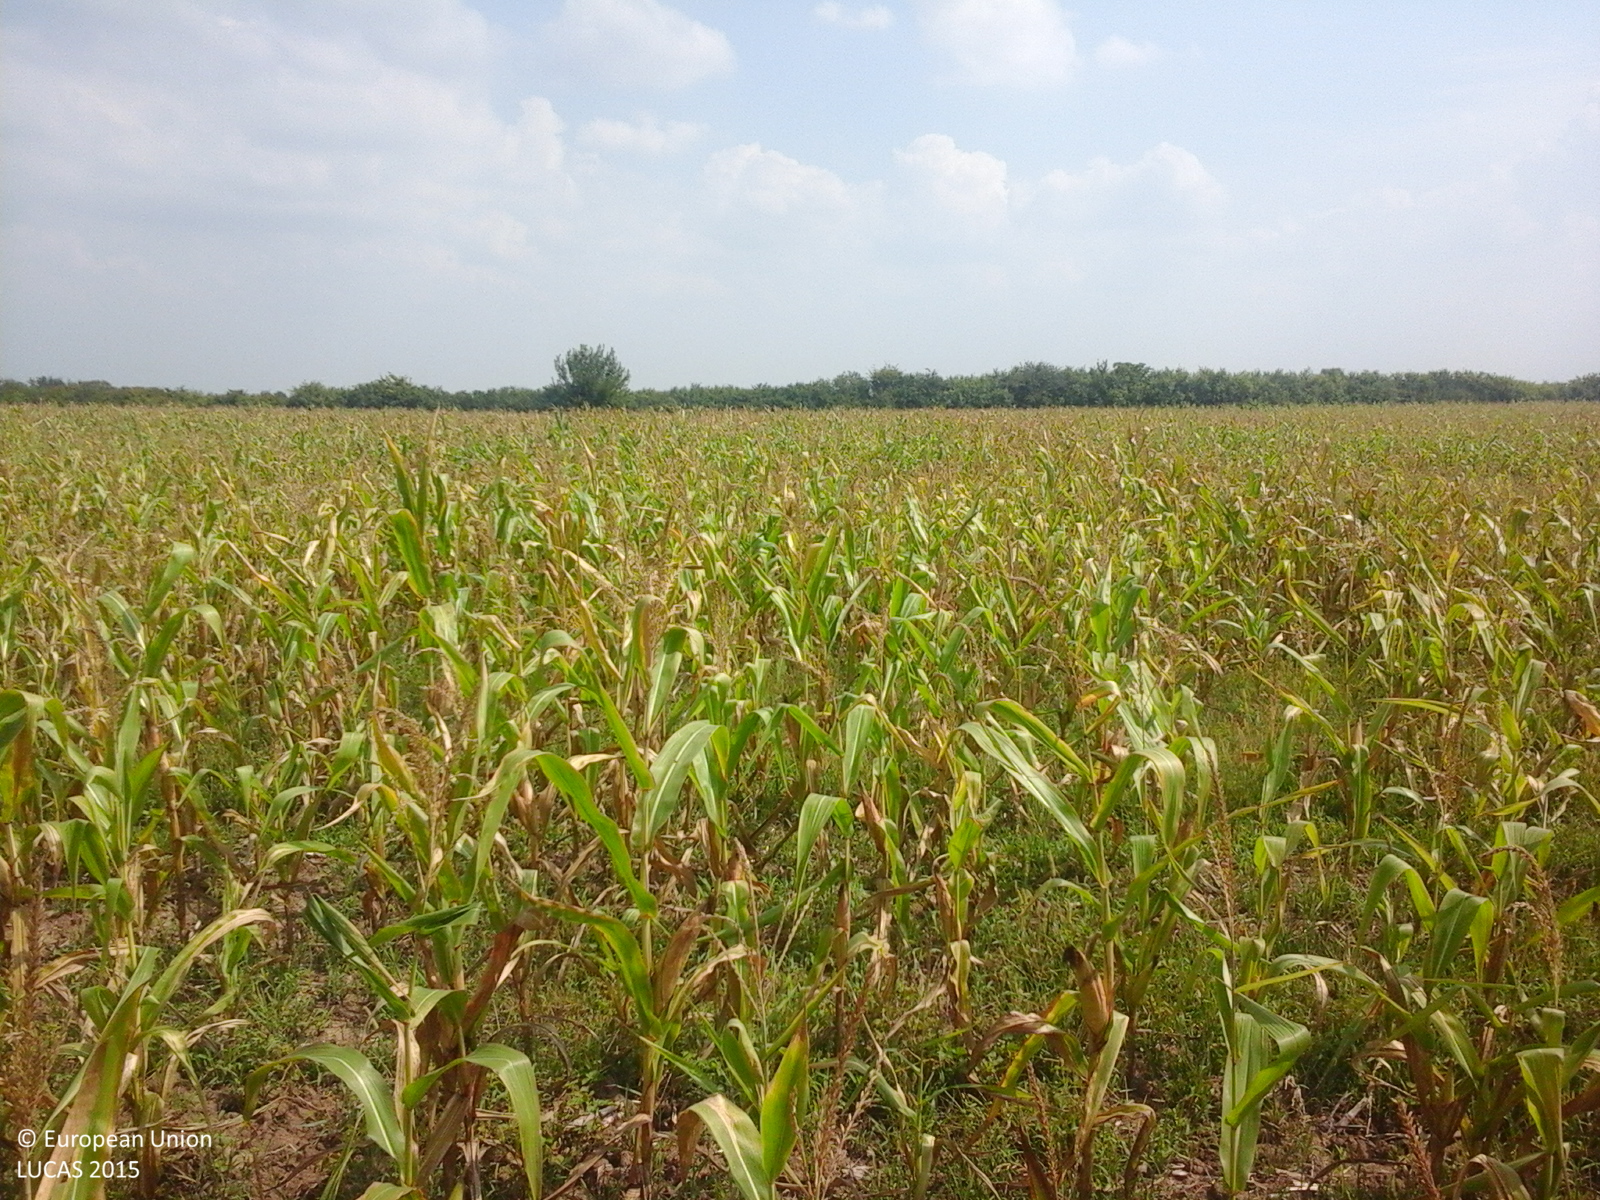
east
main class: Cropland
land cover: Maize
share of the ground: 50 - 75 %
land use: Agriculture (excluding fallow land and kitchen gardens)
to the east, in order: Maize; Spontaneously vegetated surfaces; Abandoned hedges; Ditches and canals; Abandoned hedges; Sunflower
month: August
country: RO
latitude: 46.6515
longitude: 21.7097
